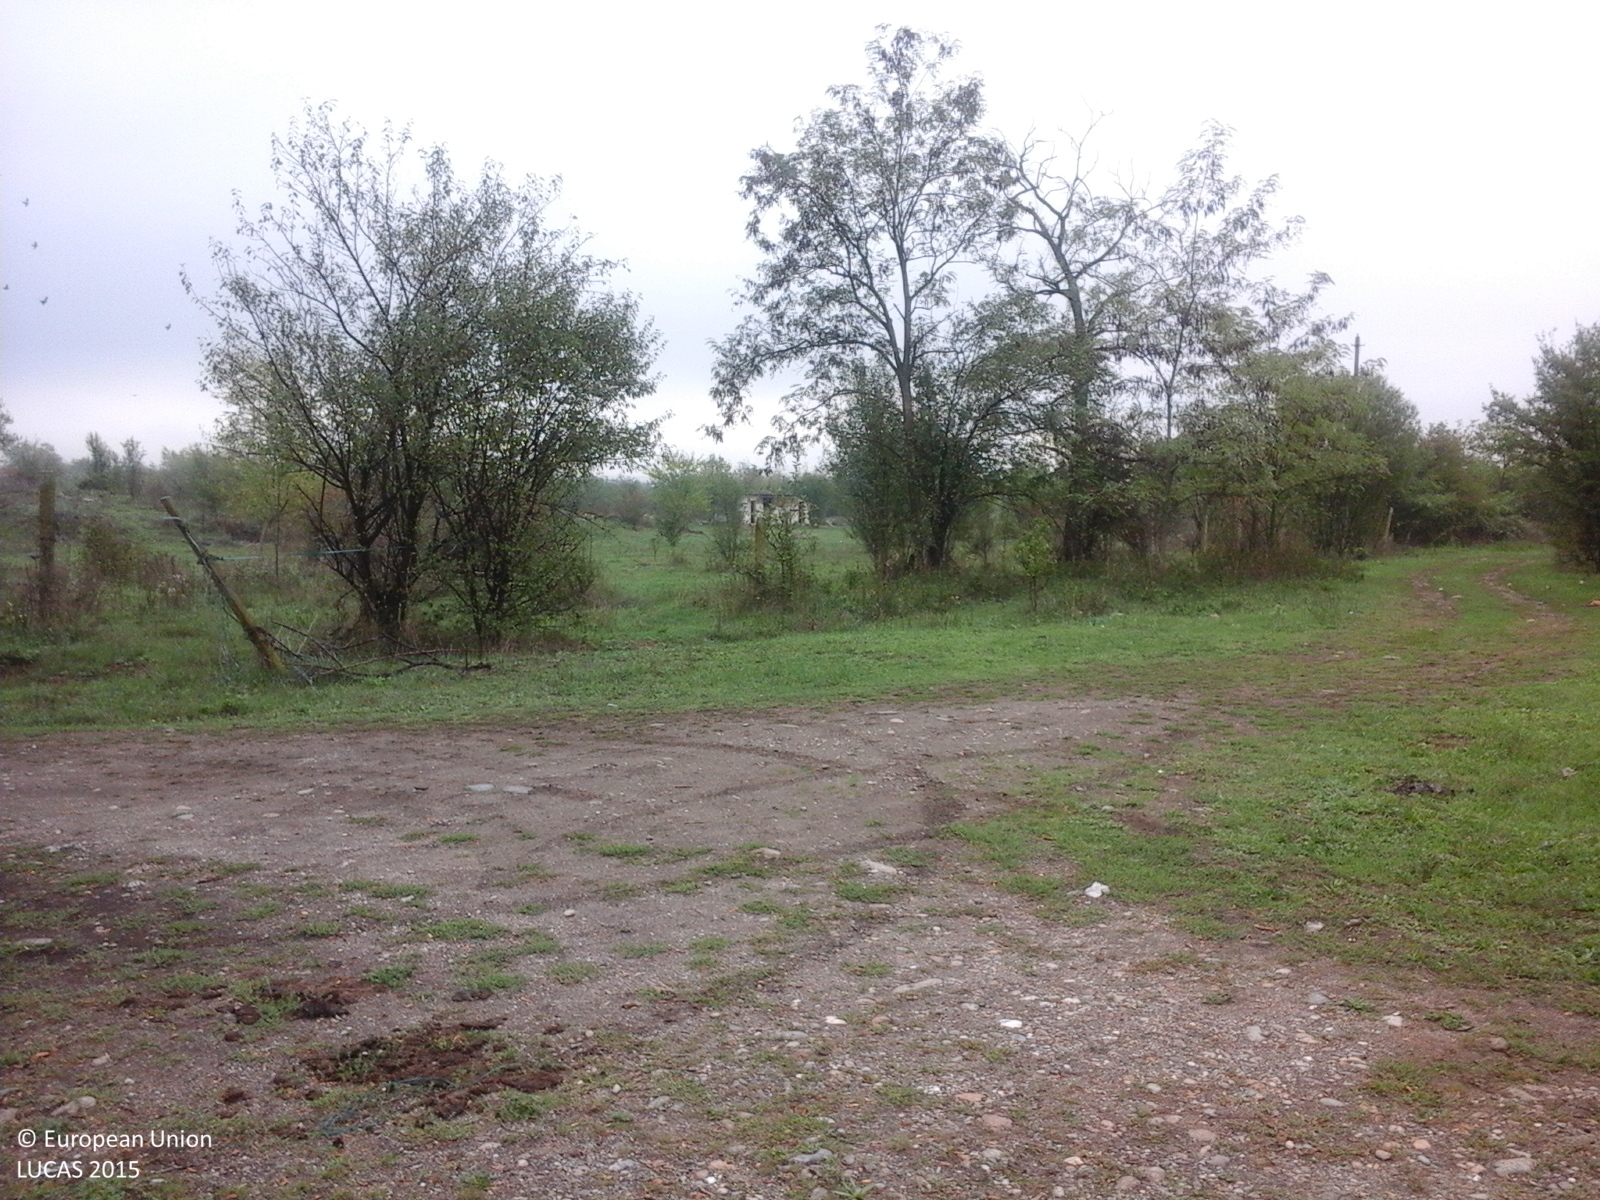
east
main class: Grassland
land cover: Grassland without tree/shrub cover
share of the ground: > 75 %
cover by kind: herbaceous plants 100 %
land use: Agriculture (excluding fallow land and kitchen gardens)
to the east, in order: Grassland without tree/shrub cover; Tracks; Grassland with sparse tree/shrub cover; Fences; Grassland with sparse tree/shrub cover; Artificial constructions in urban areas; Grassland with sparse tree/shrub cover
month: September
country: RO
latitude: 45.0424
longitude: 23.2954
